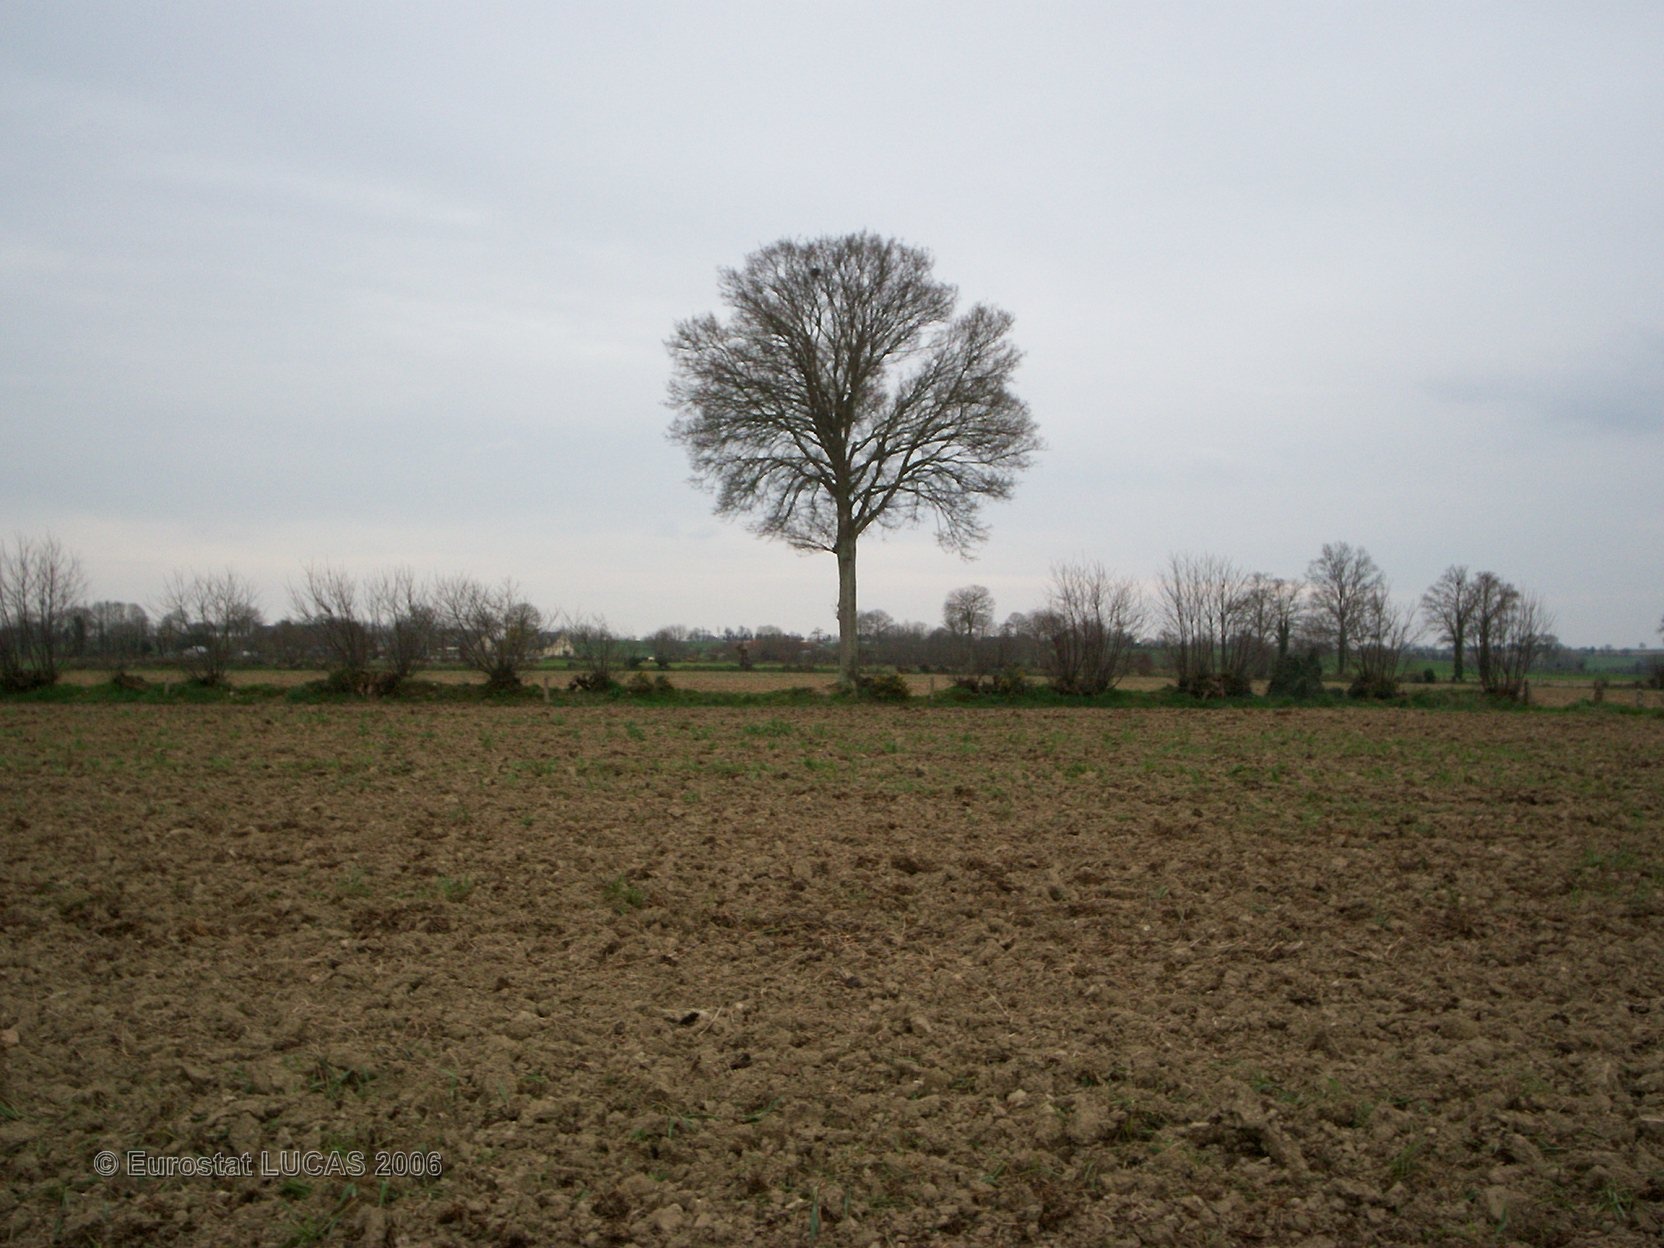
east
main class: Cropland
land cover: Maize
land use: Agriculture (excluding fallow land and kitchen gardens)
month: April
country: FR
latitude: 48.4816
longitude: -1.4237
